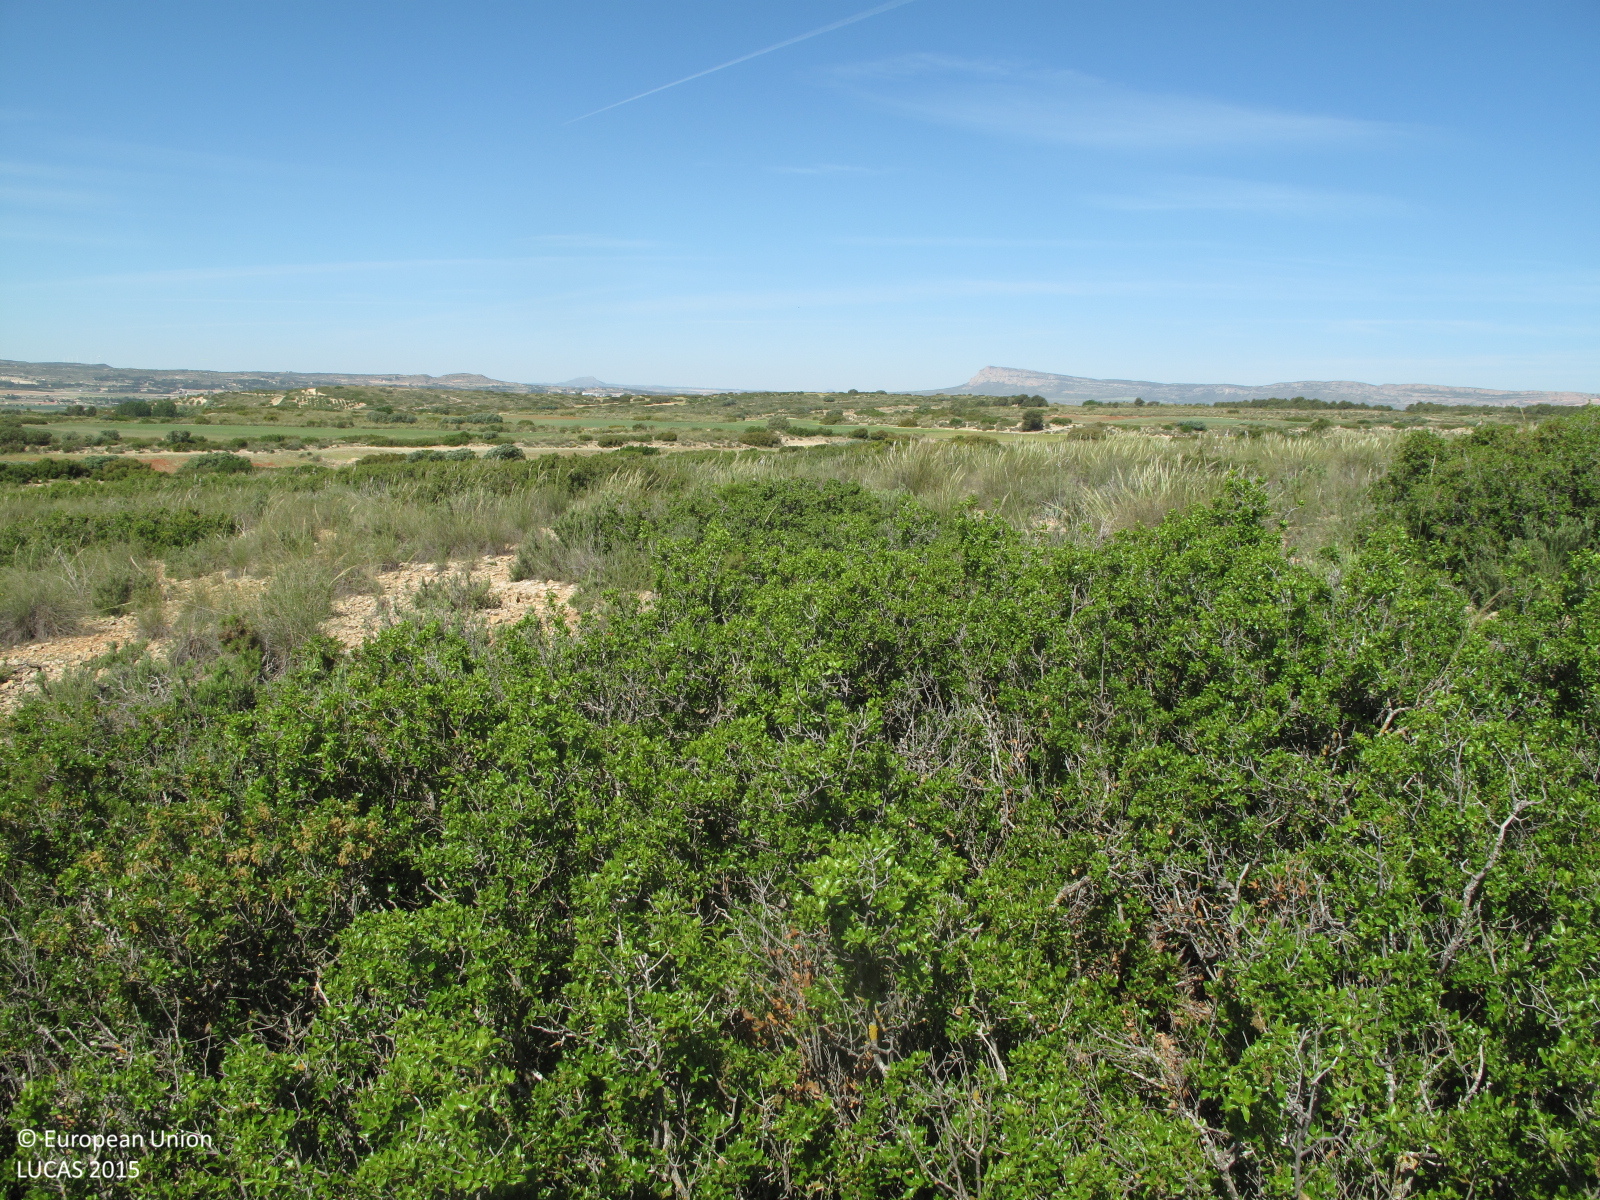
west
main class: Shrubland
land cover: Shrubland with sparse tree cover
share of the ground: 25 - 50 %
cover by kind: consolidated bare surface 45 %, shrubs 40 %, herbaceous plants 10 %, broadleaved forest trees 5 %
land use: Semi-natural and natural areas not in use
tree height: > 5 m
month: May
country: ES
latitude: 38.8773
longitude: -1.0250
